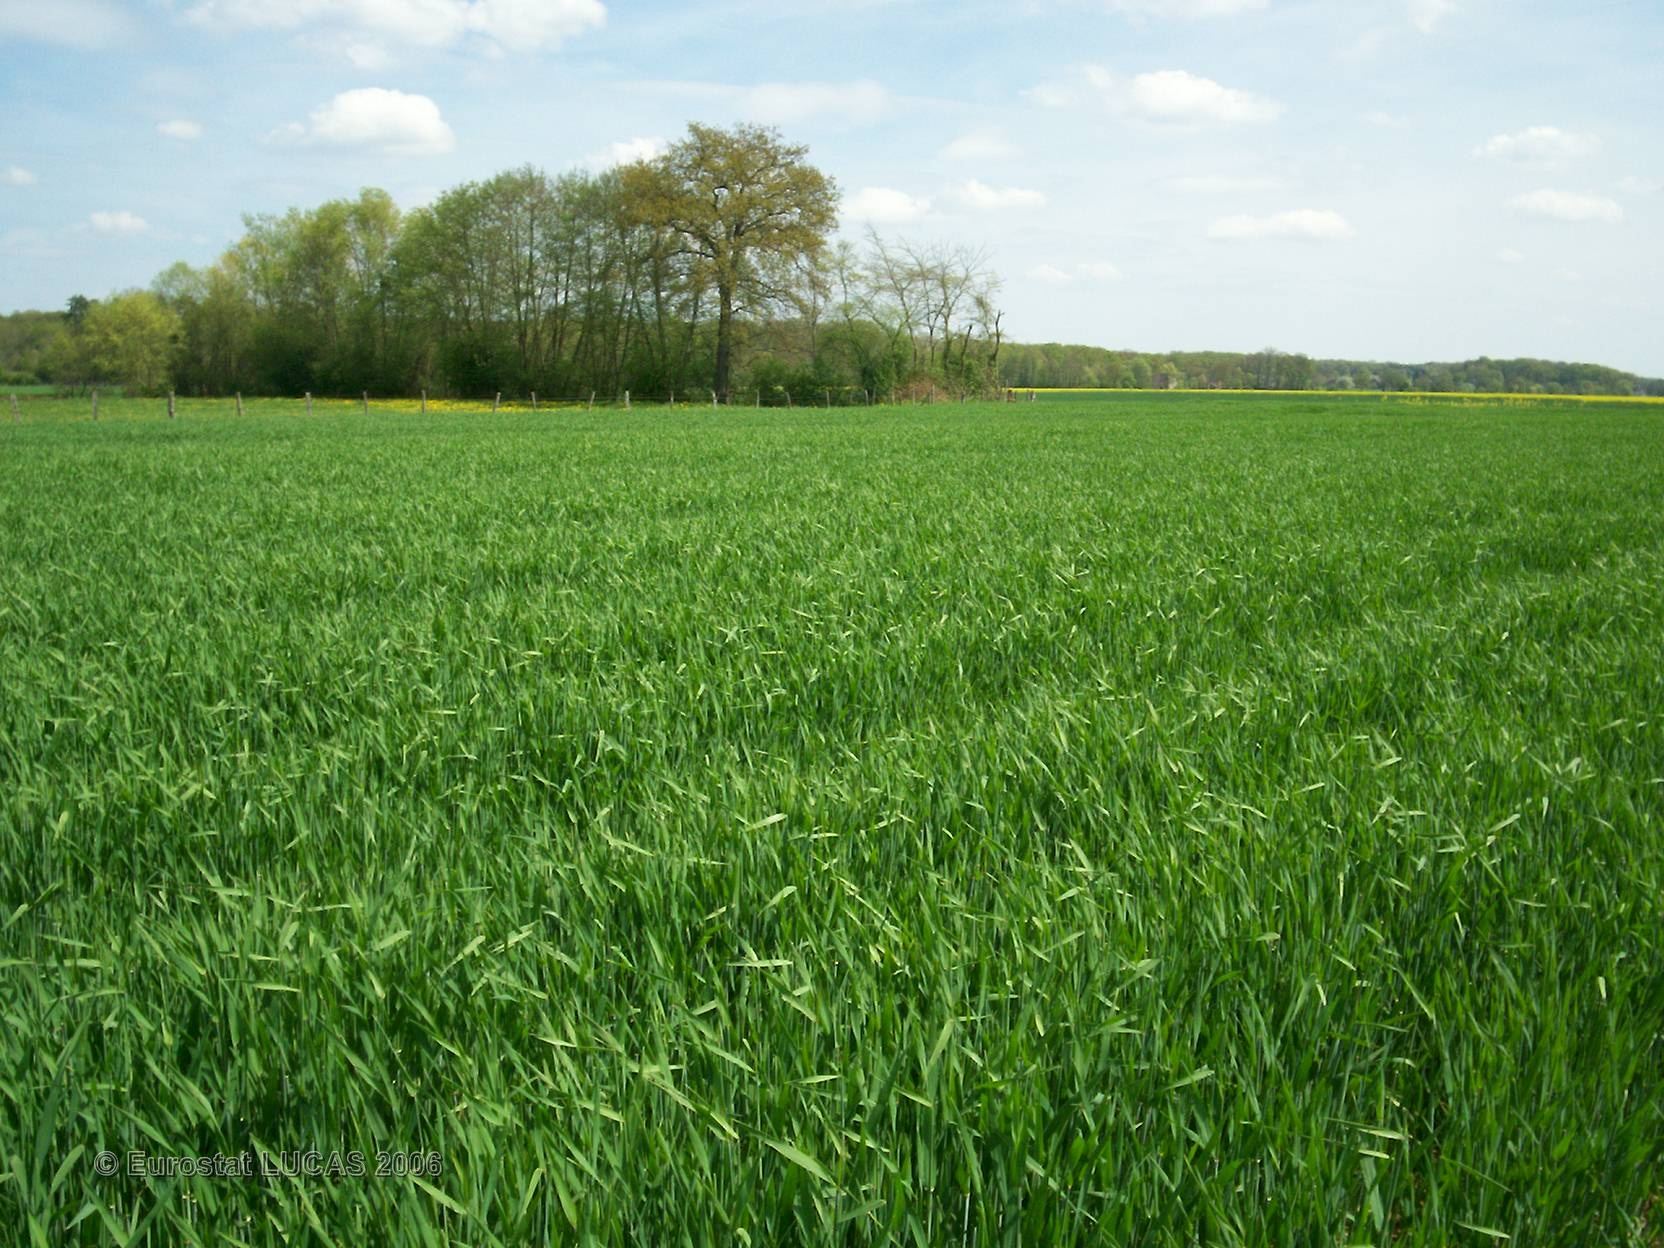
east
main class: Cropland
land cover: Barley
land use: Agriculture (excluding fallow land and kitchen gardens)
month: May
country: FR
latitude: 48.0213
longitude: 3.9494
